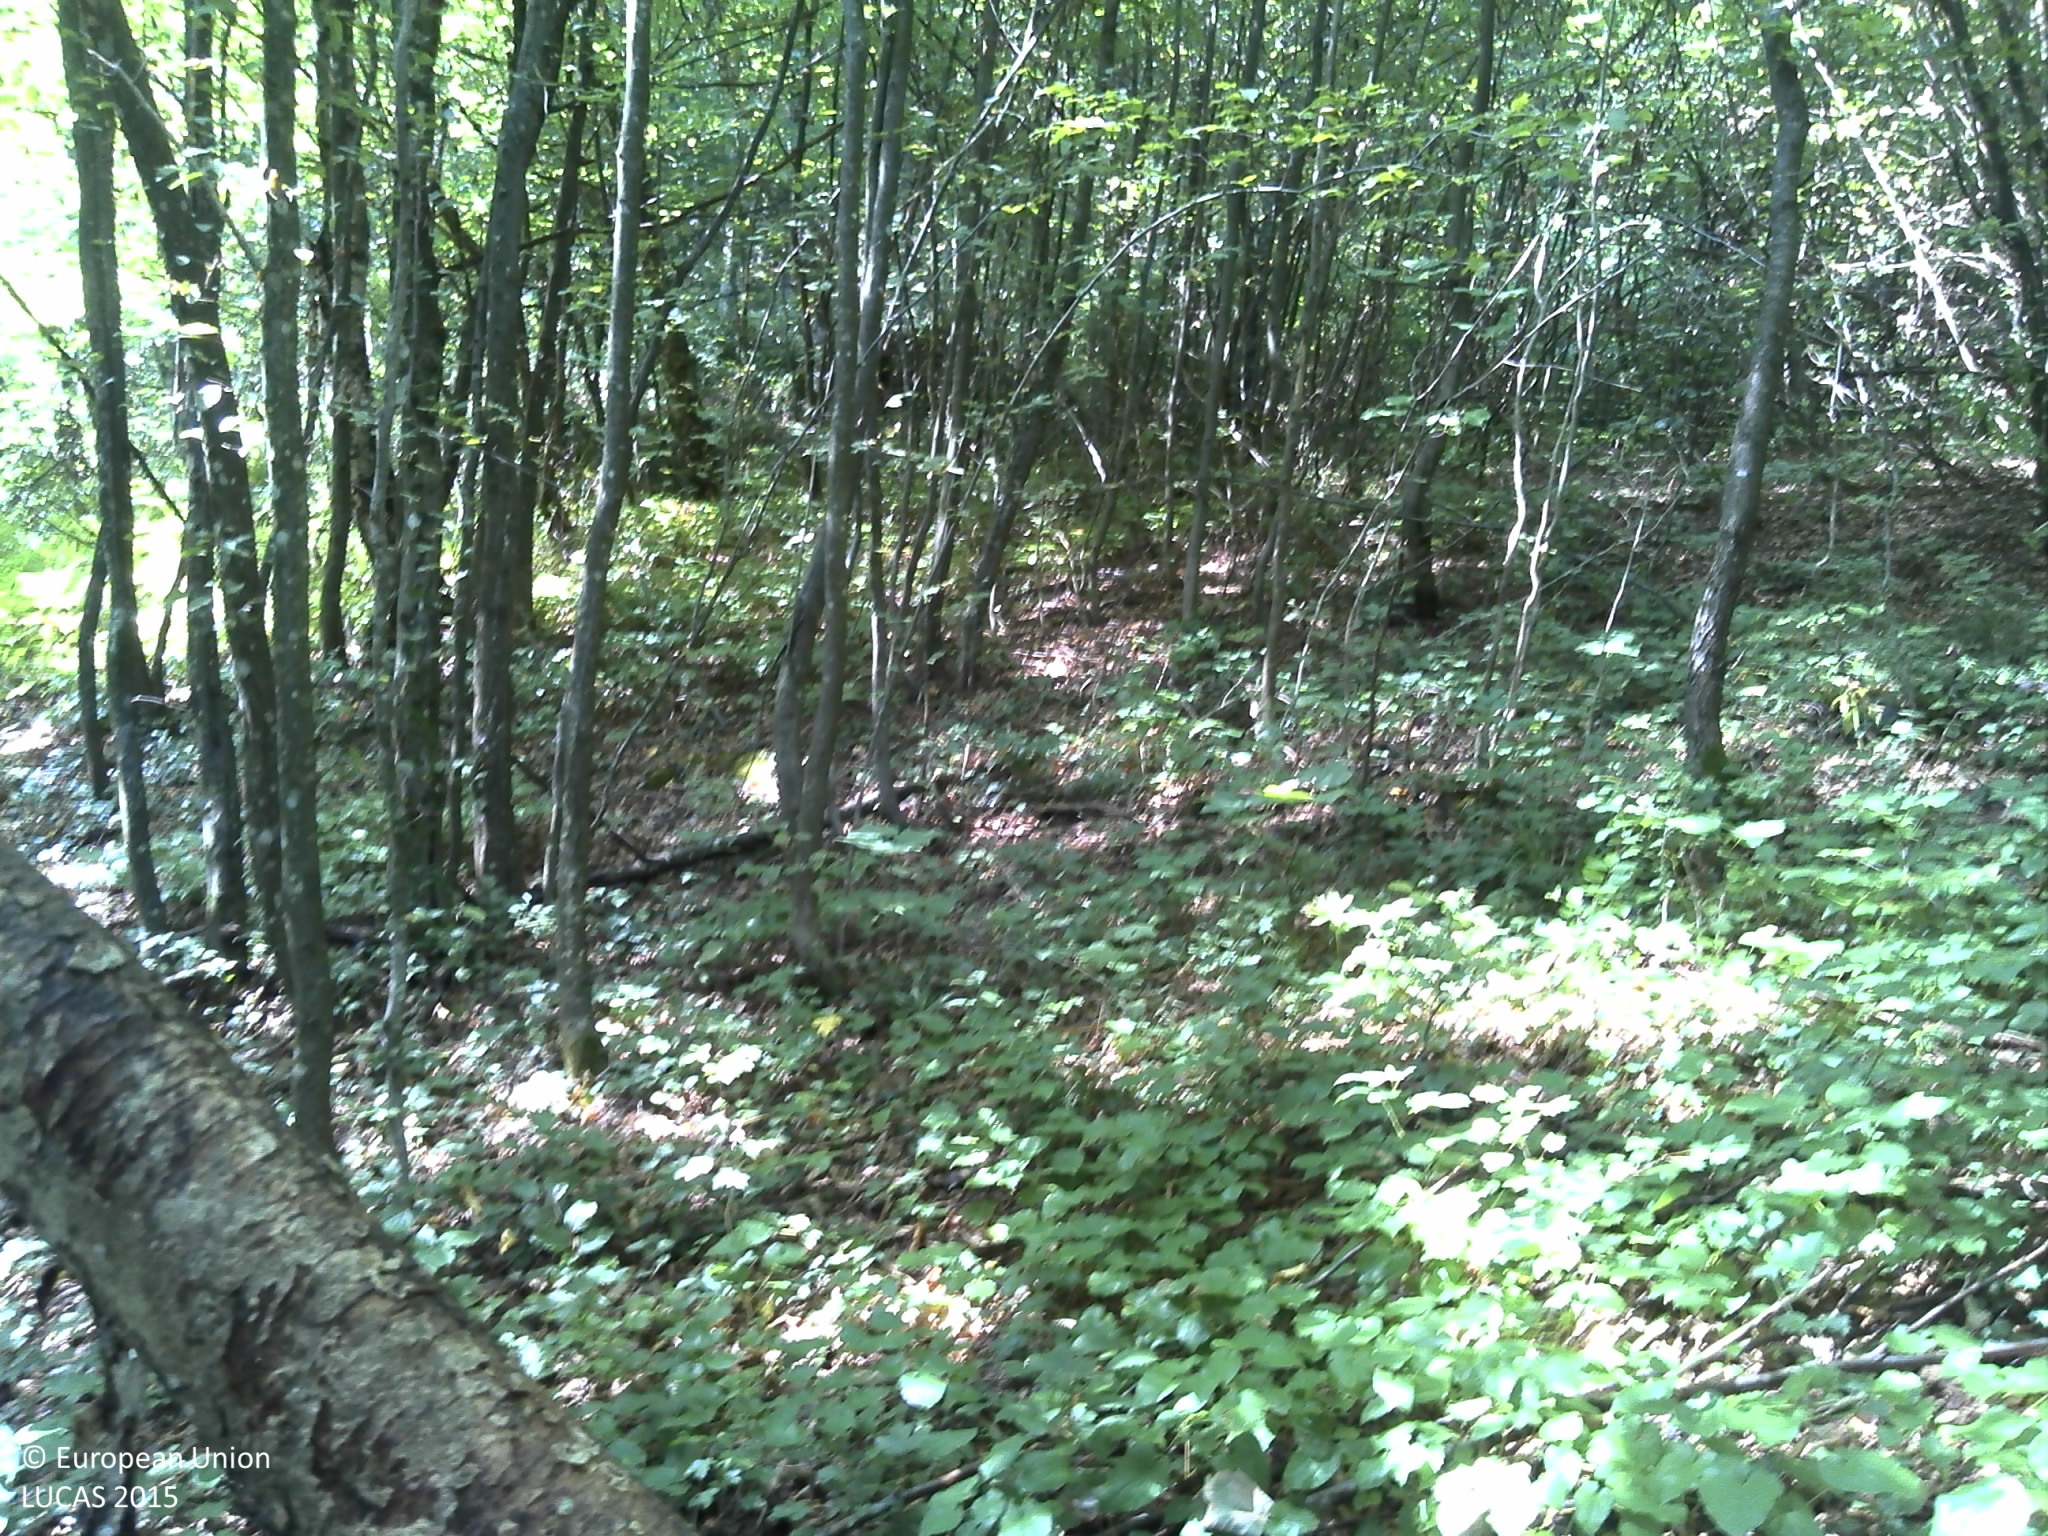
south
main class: Woodland
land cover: Broadleaved woodland
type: acidophilous oak and oak-birch forest
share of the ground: > 75 %
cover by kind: broadleaved forest trees 100 %
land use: Forestry
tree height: > 5 m
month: August
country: HR
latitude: 45.1764
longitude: 15.2250
